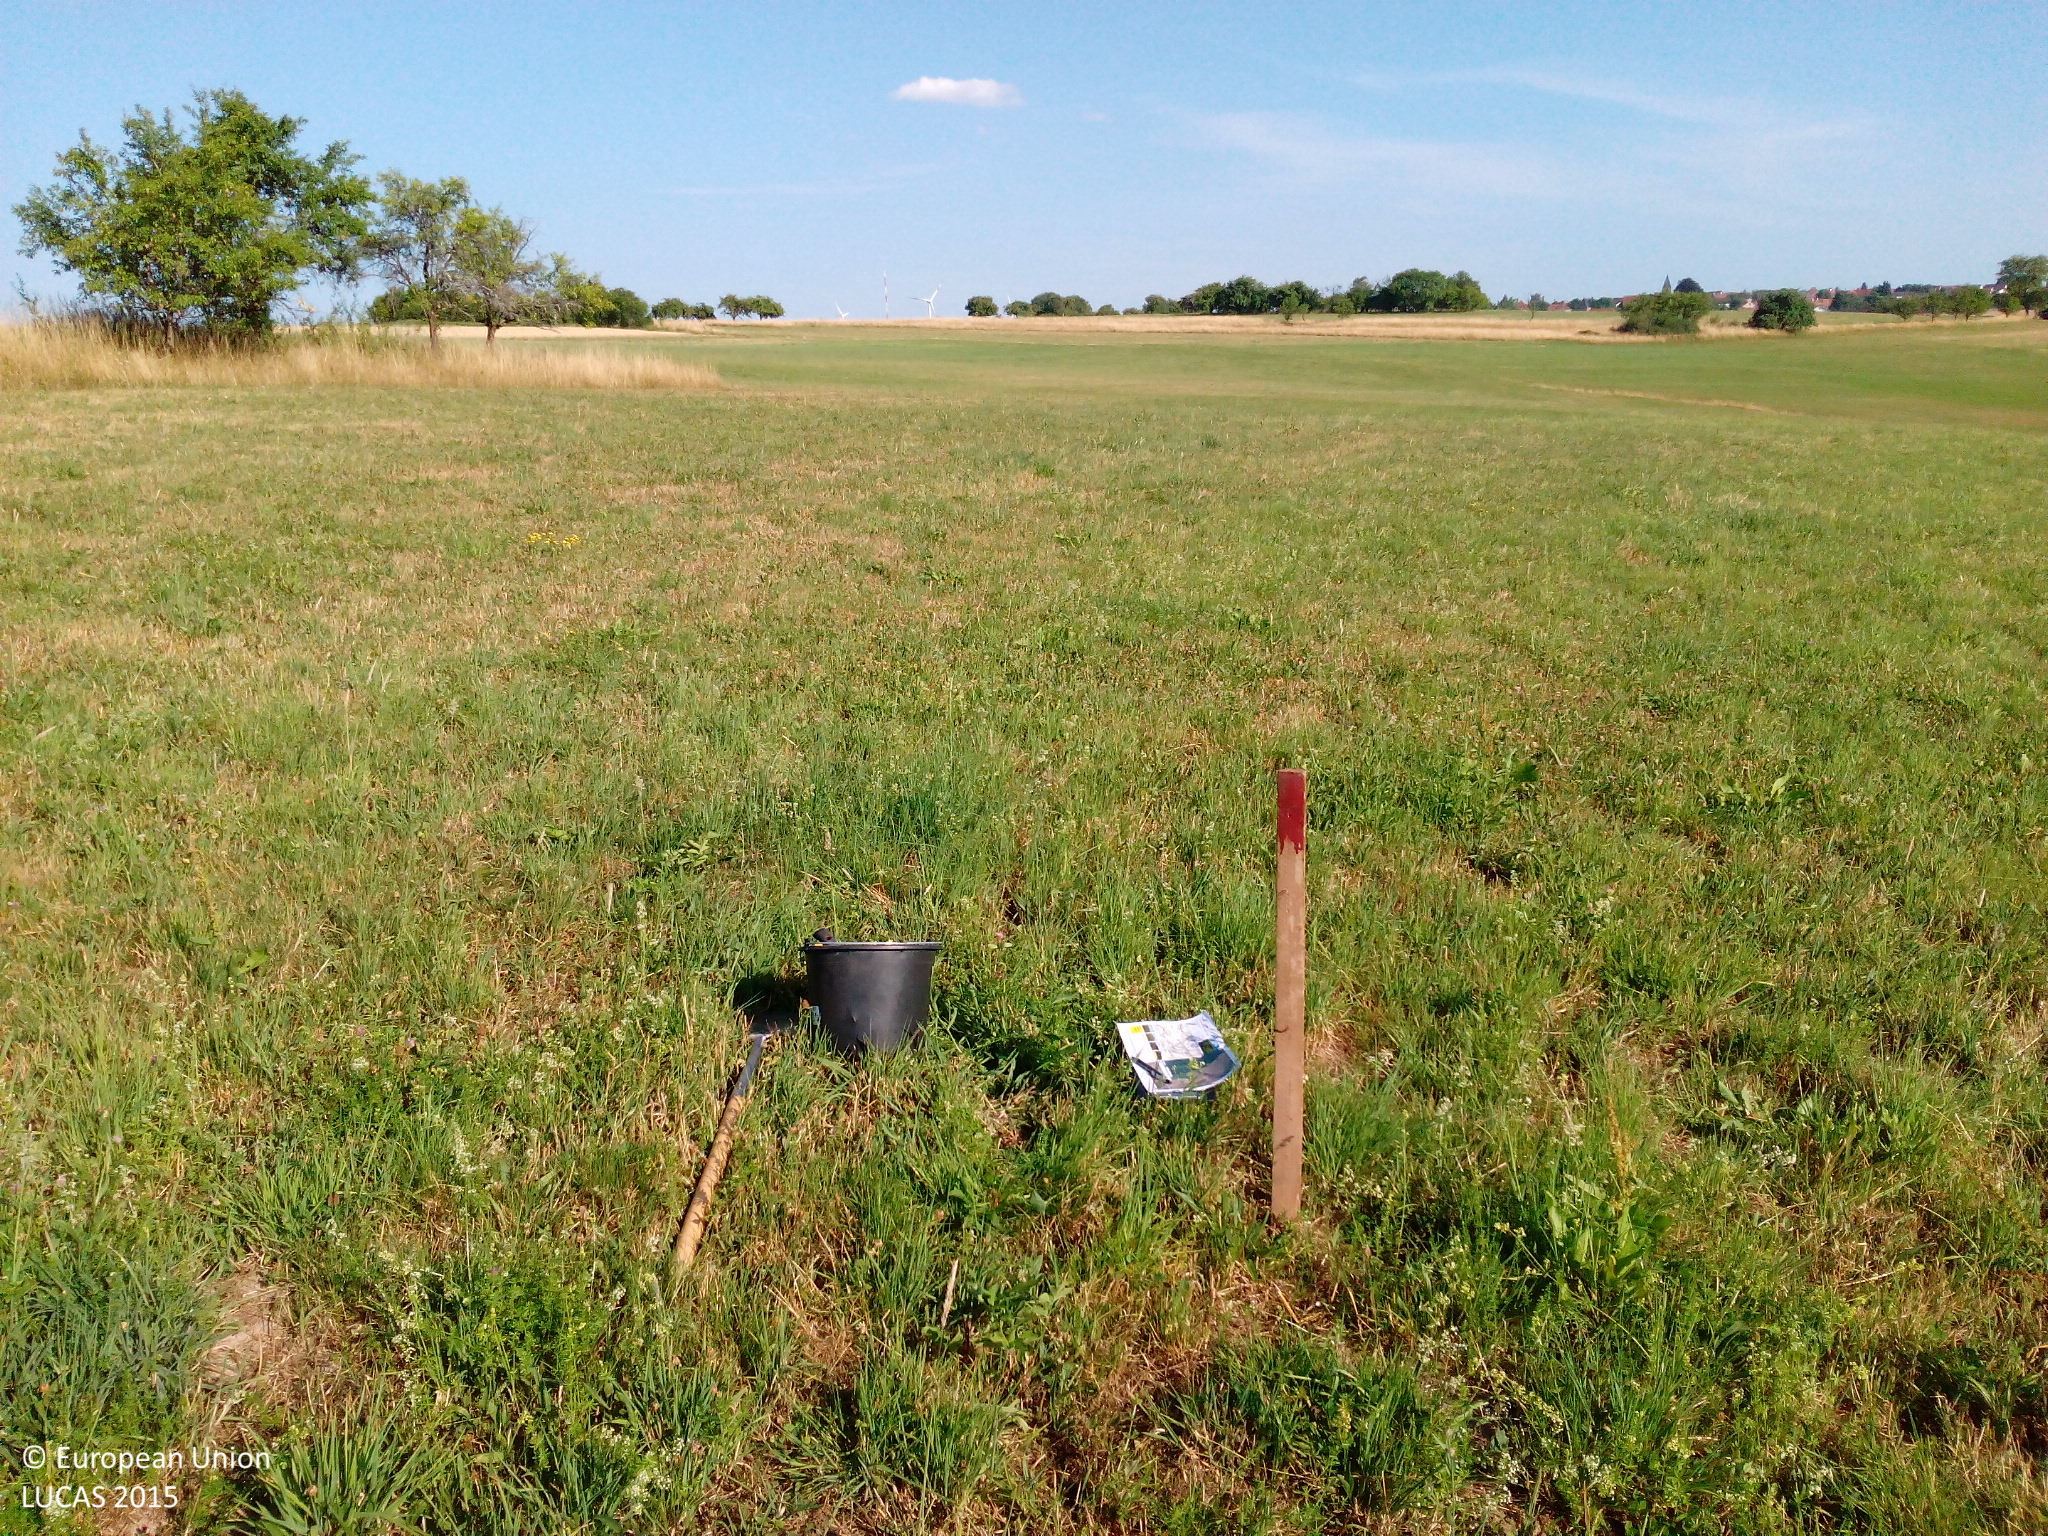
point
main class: Grassland
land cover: Grassland without tree/shrub cover
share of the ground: > 75 %
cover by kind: herbaceous plants 90 %, unconsolidated bare surface 10 %
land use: Agriculture (excluding fallow land and kitchen gardens)
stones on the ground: < 10 %
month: July
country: DE
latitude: 49.1682
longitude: 7.5455
